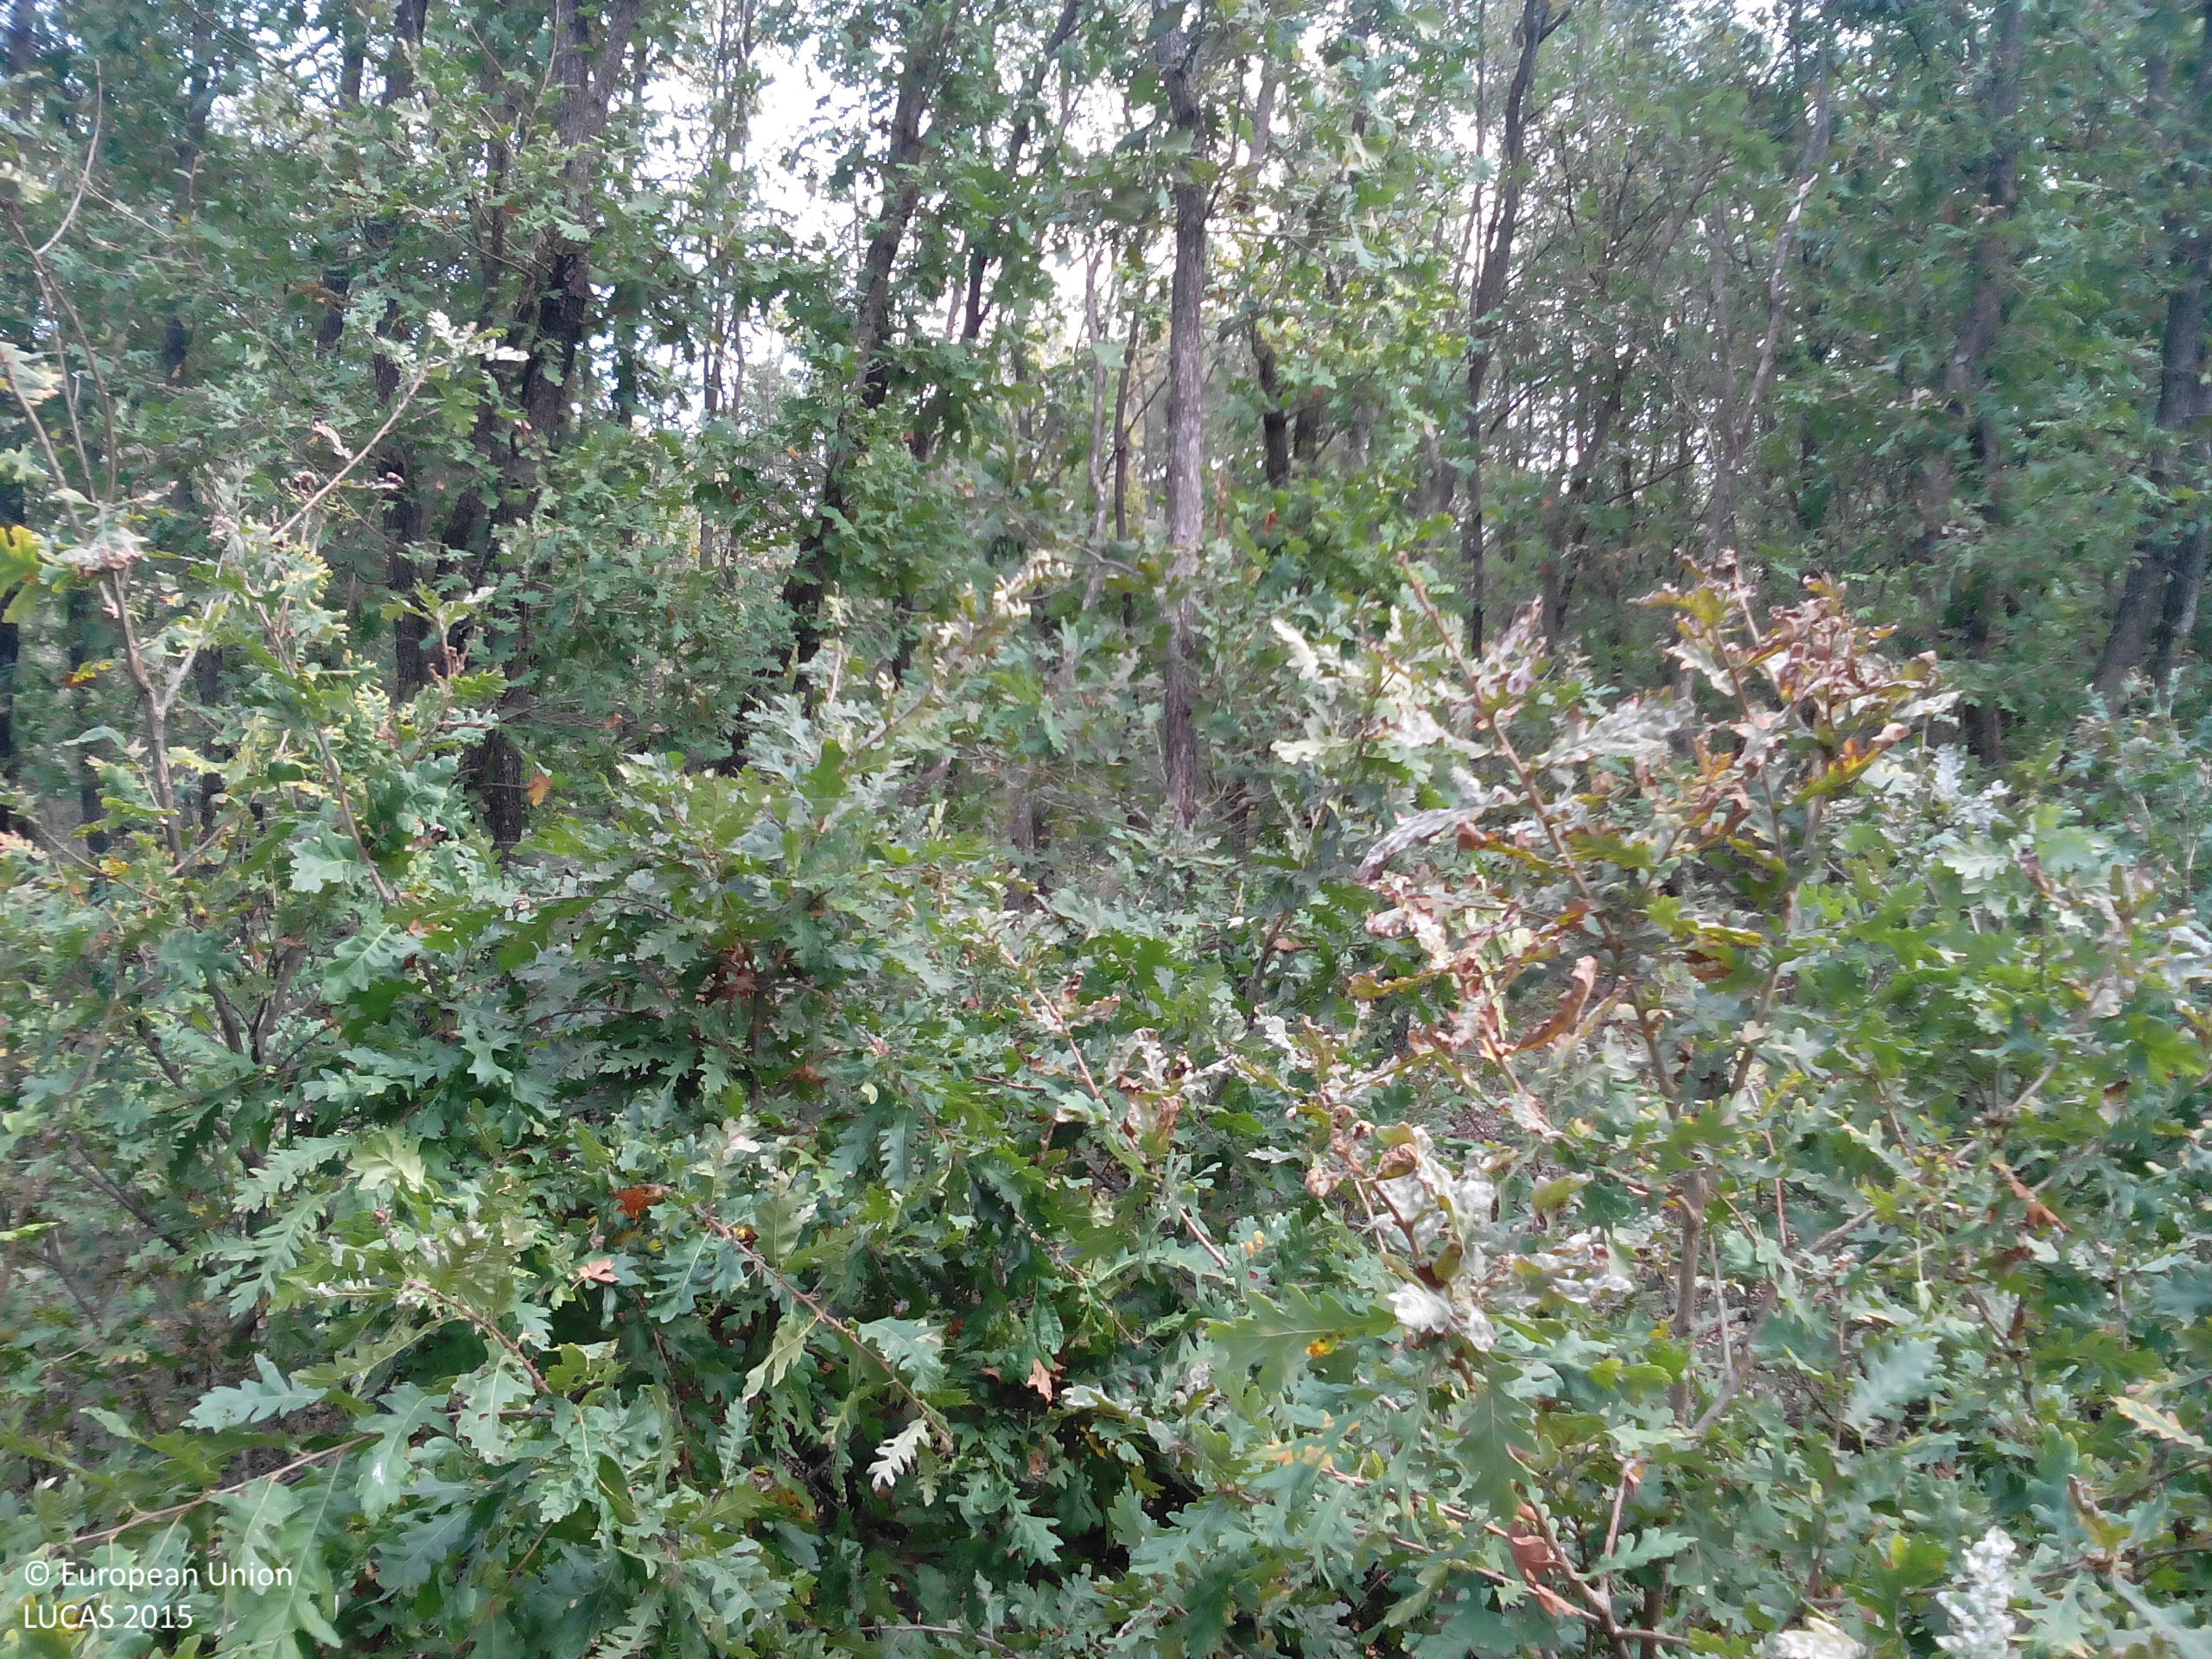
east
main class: Woodland
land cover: Broadleaved woodland
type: acidophilous oak and oak-birch forest
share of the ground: > 75 %
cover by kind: broadleaved forest trees 75 %, shrubs 15 %, herbaceous plants 10 %
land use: Forestry
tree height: > 5 m
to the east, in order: Broadleaved woodland
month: October
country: BG
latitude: 43.2103
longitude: 24.0208
